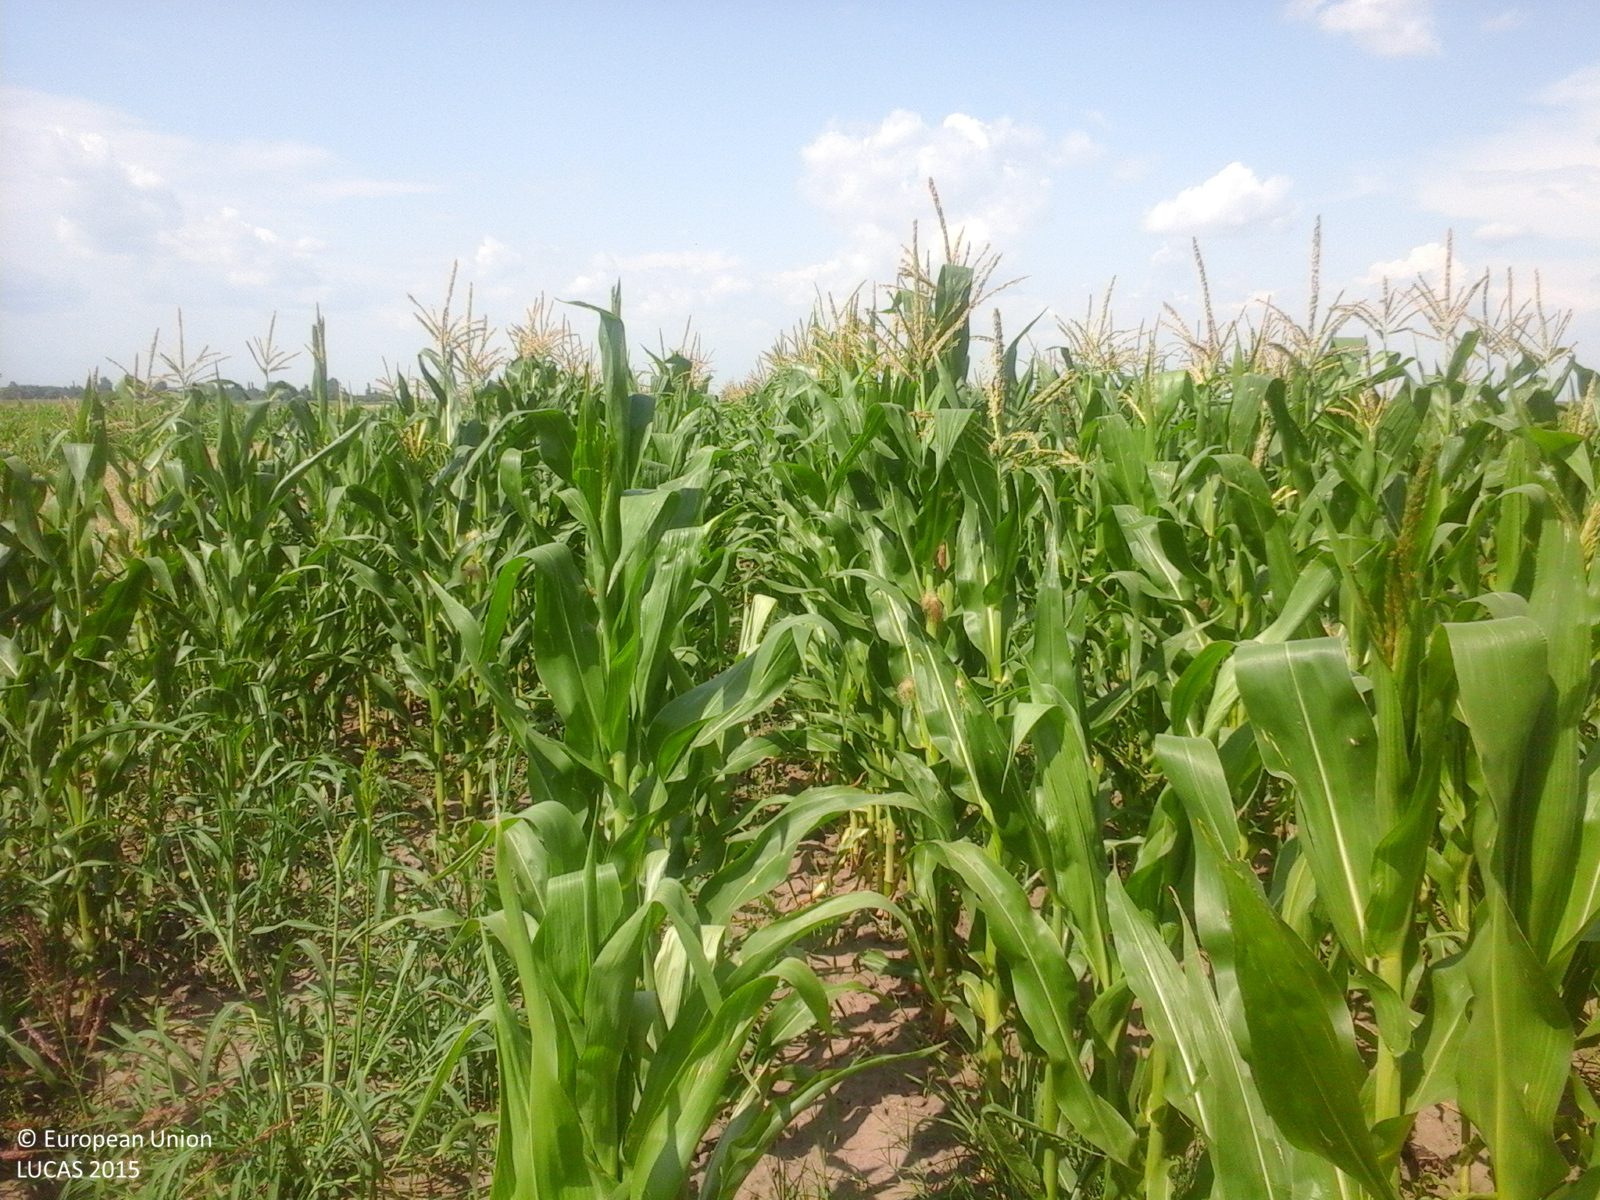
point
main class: Cropland
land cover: Maize
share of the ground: > 75 %
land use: Agriculture (excluding fallow land and kitchen gardens)
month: July
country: RO
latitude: 43.9741
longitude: 24.1838
